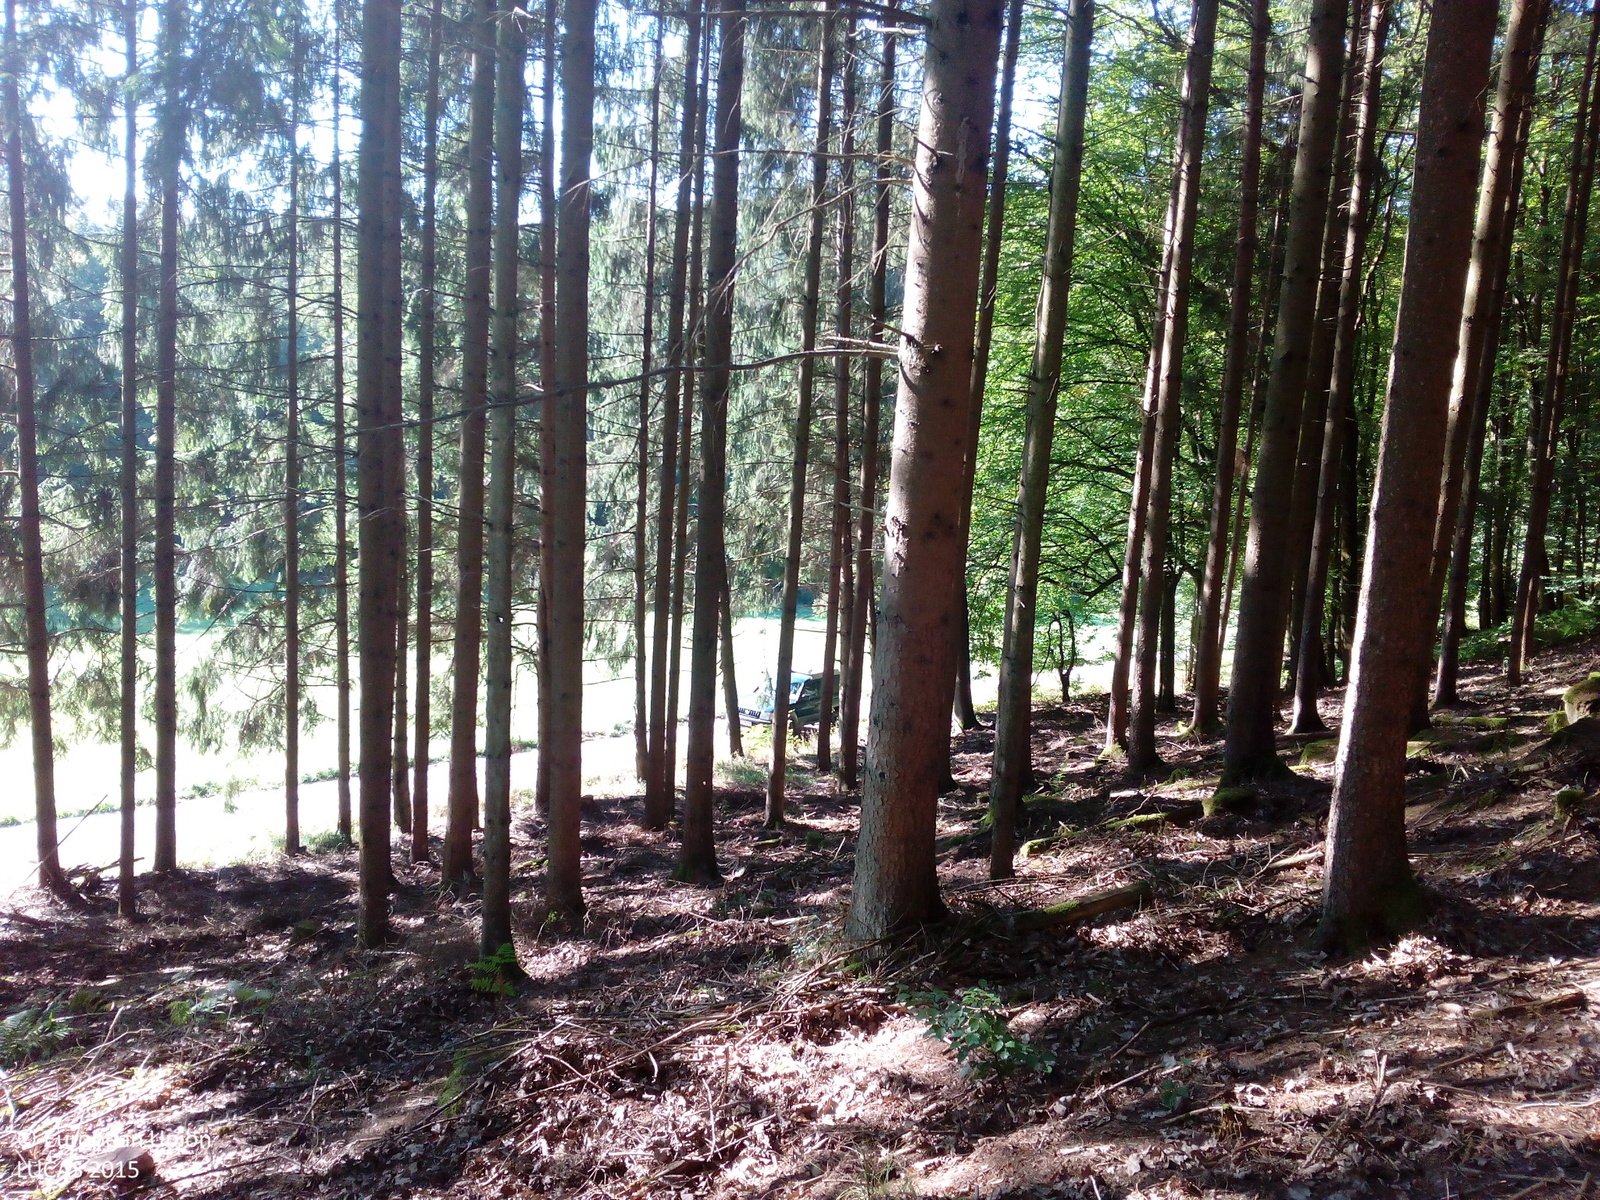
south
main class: Woodland
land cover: Spruce dominated coniferous woodland
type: hemiboreal forest and nemoral coniferous forest and mixed broadleaved-coniferous forest
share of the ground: > 75 %
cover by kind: coniferous forest trees 90 %, unconsolidated bare surface 10 %
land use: Forestry
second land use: Amenities, museums, leisure
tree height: > 5 m
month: September
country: DE
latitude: 49.9137
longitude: 9.5684
